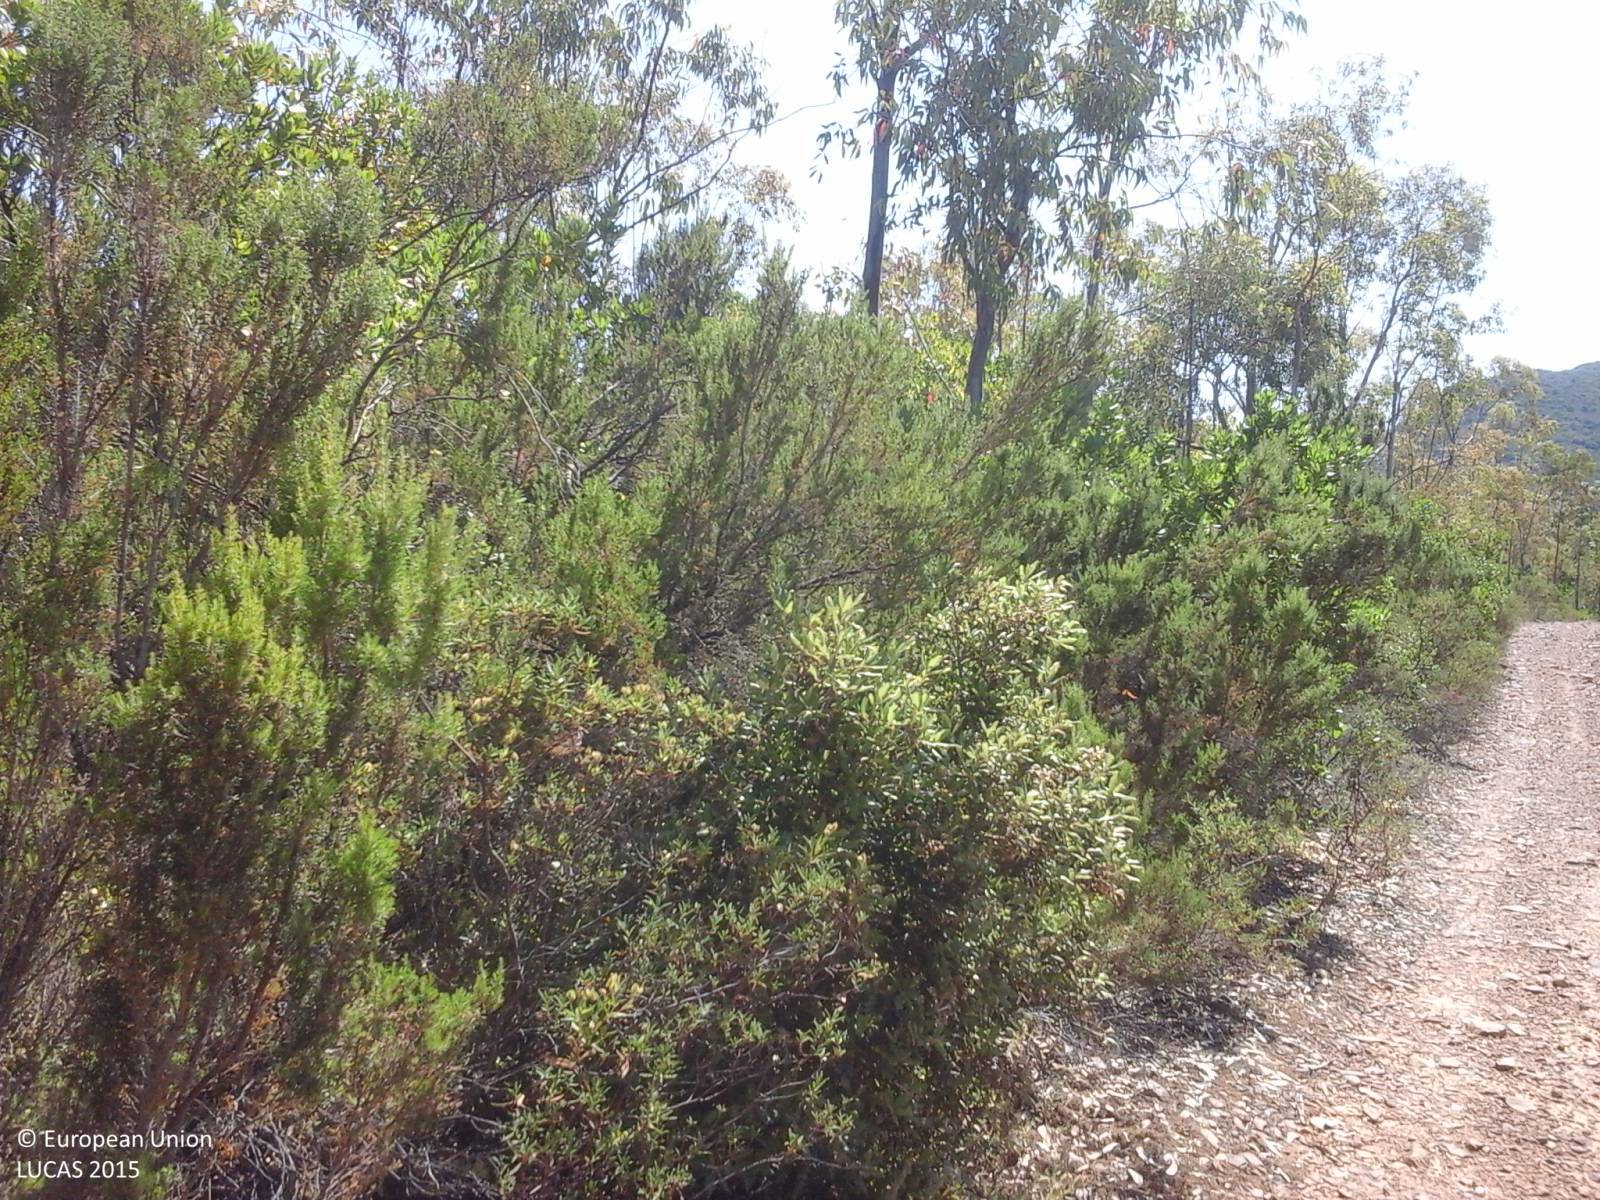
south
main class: Shrubland
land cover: Shrubland with sparse tree cover
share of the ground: > 75 %
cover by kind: shrubs 95 %, broadleaved forest trees 5 %
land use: Semi-natural and natural areas not in use
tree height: < 5 m
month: June
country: IT
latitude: 39.2098
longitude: 8.8376
